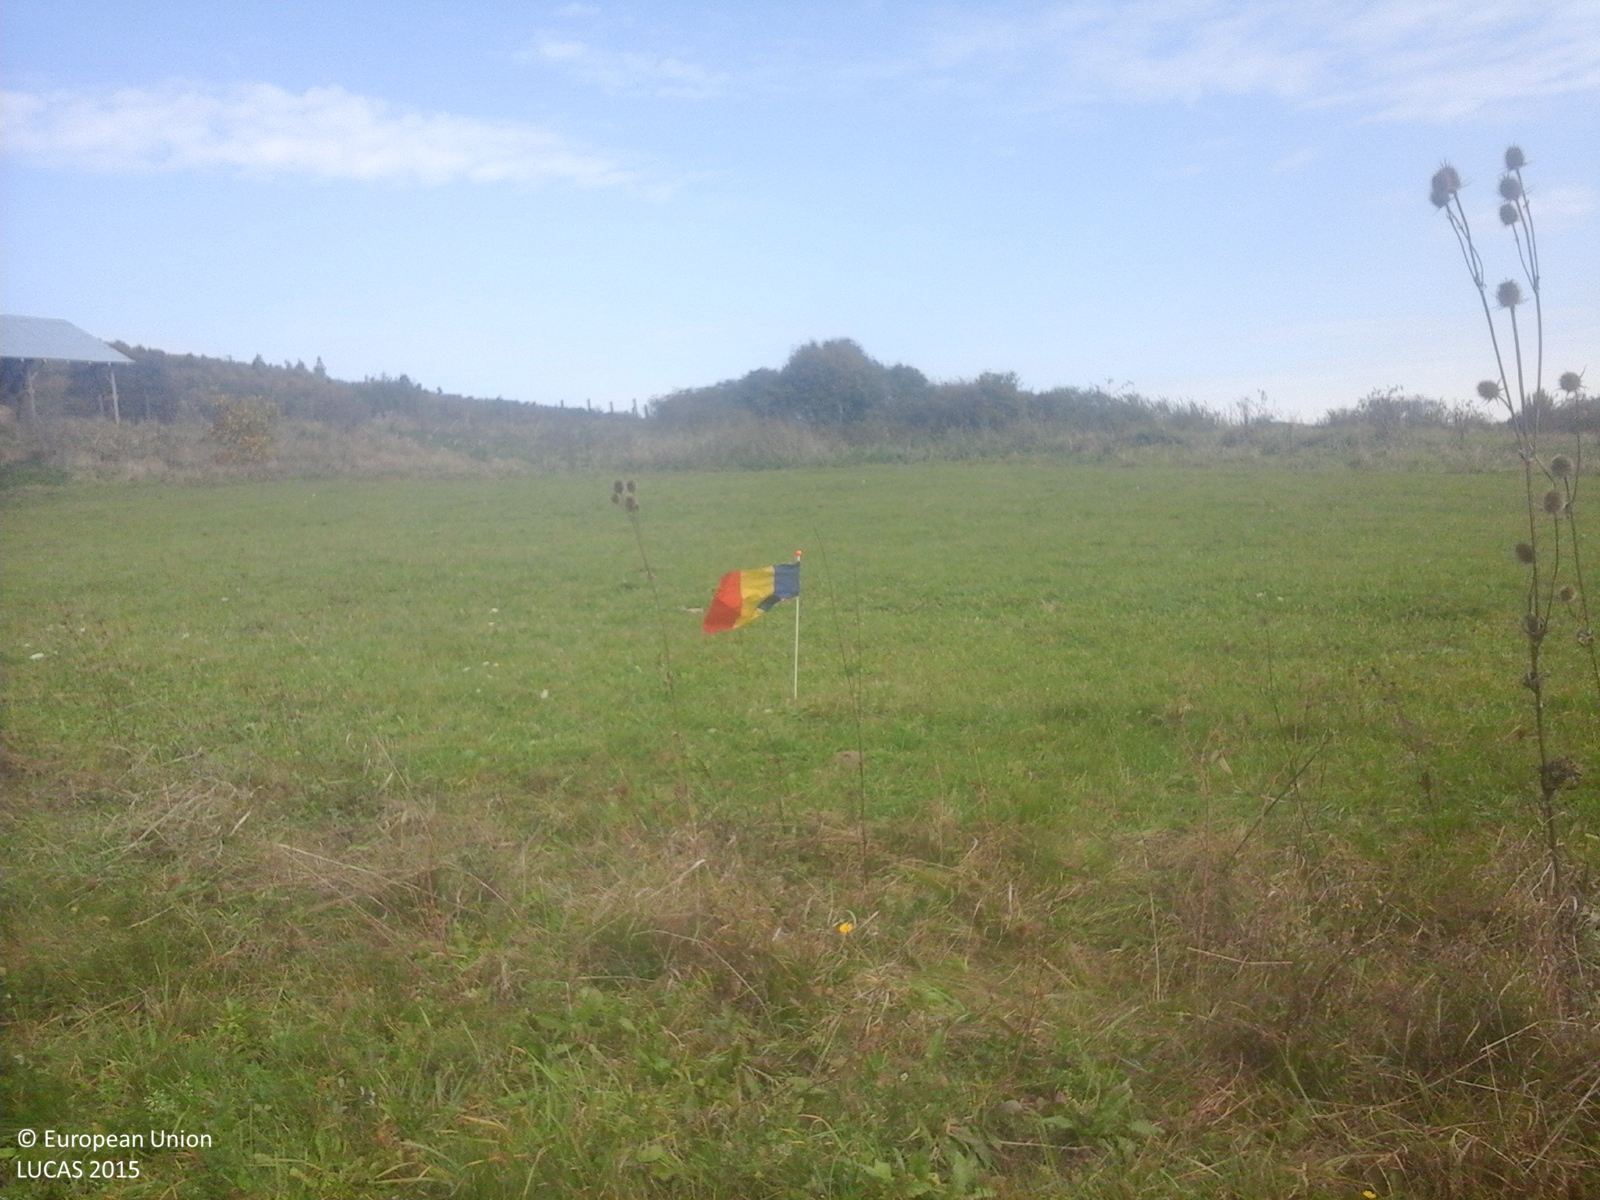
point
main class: Grassland
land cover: Grassland without tree/shrub cover
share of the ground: > 75 %
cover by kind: herbaceous plants 100 %
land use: Agriculture (excluding fallow land and kitchen gardens)
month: October
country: RO
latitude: 46.2474
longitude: 25.3169
